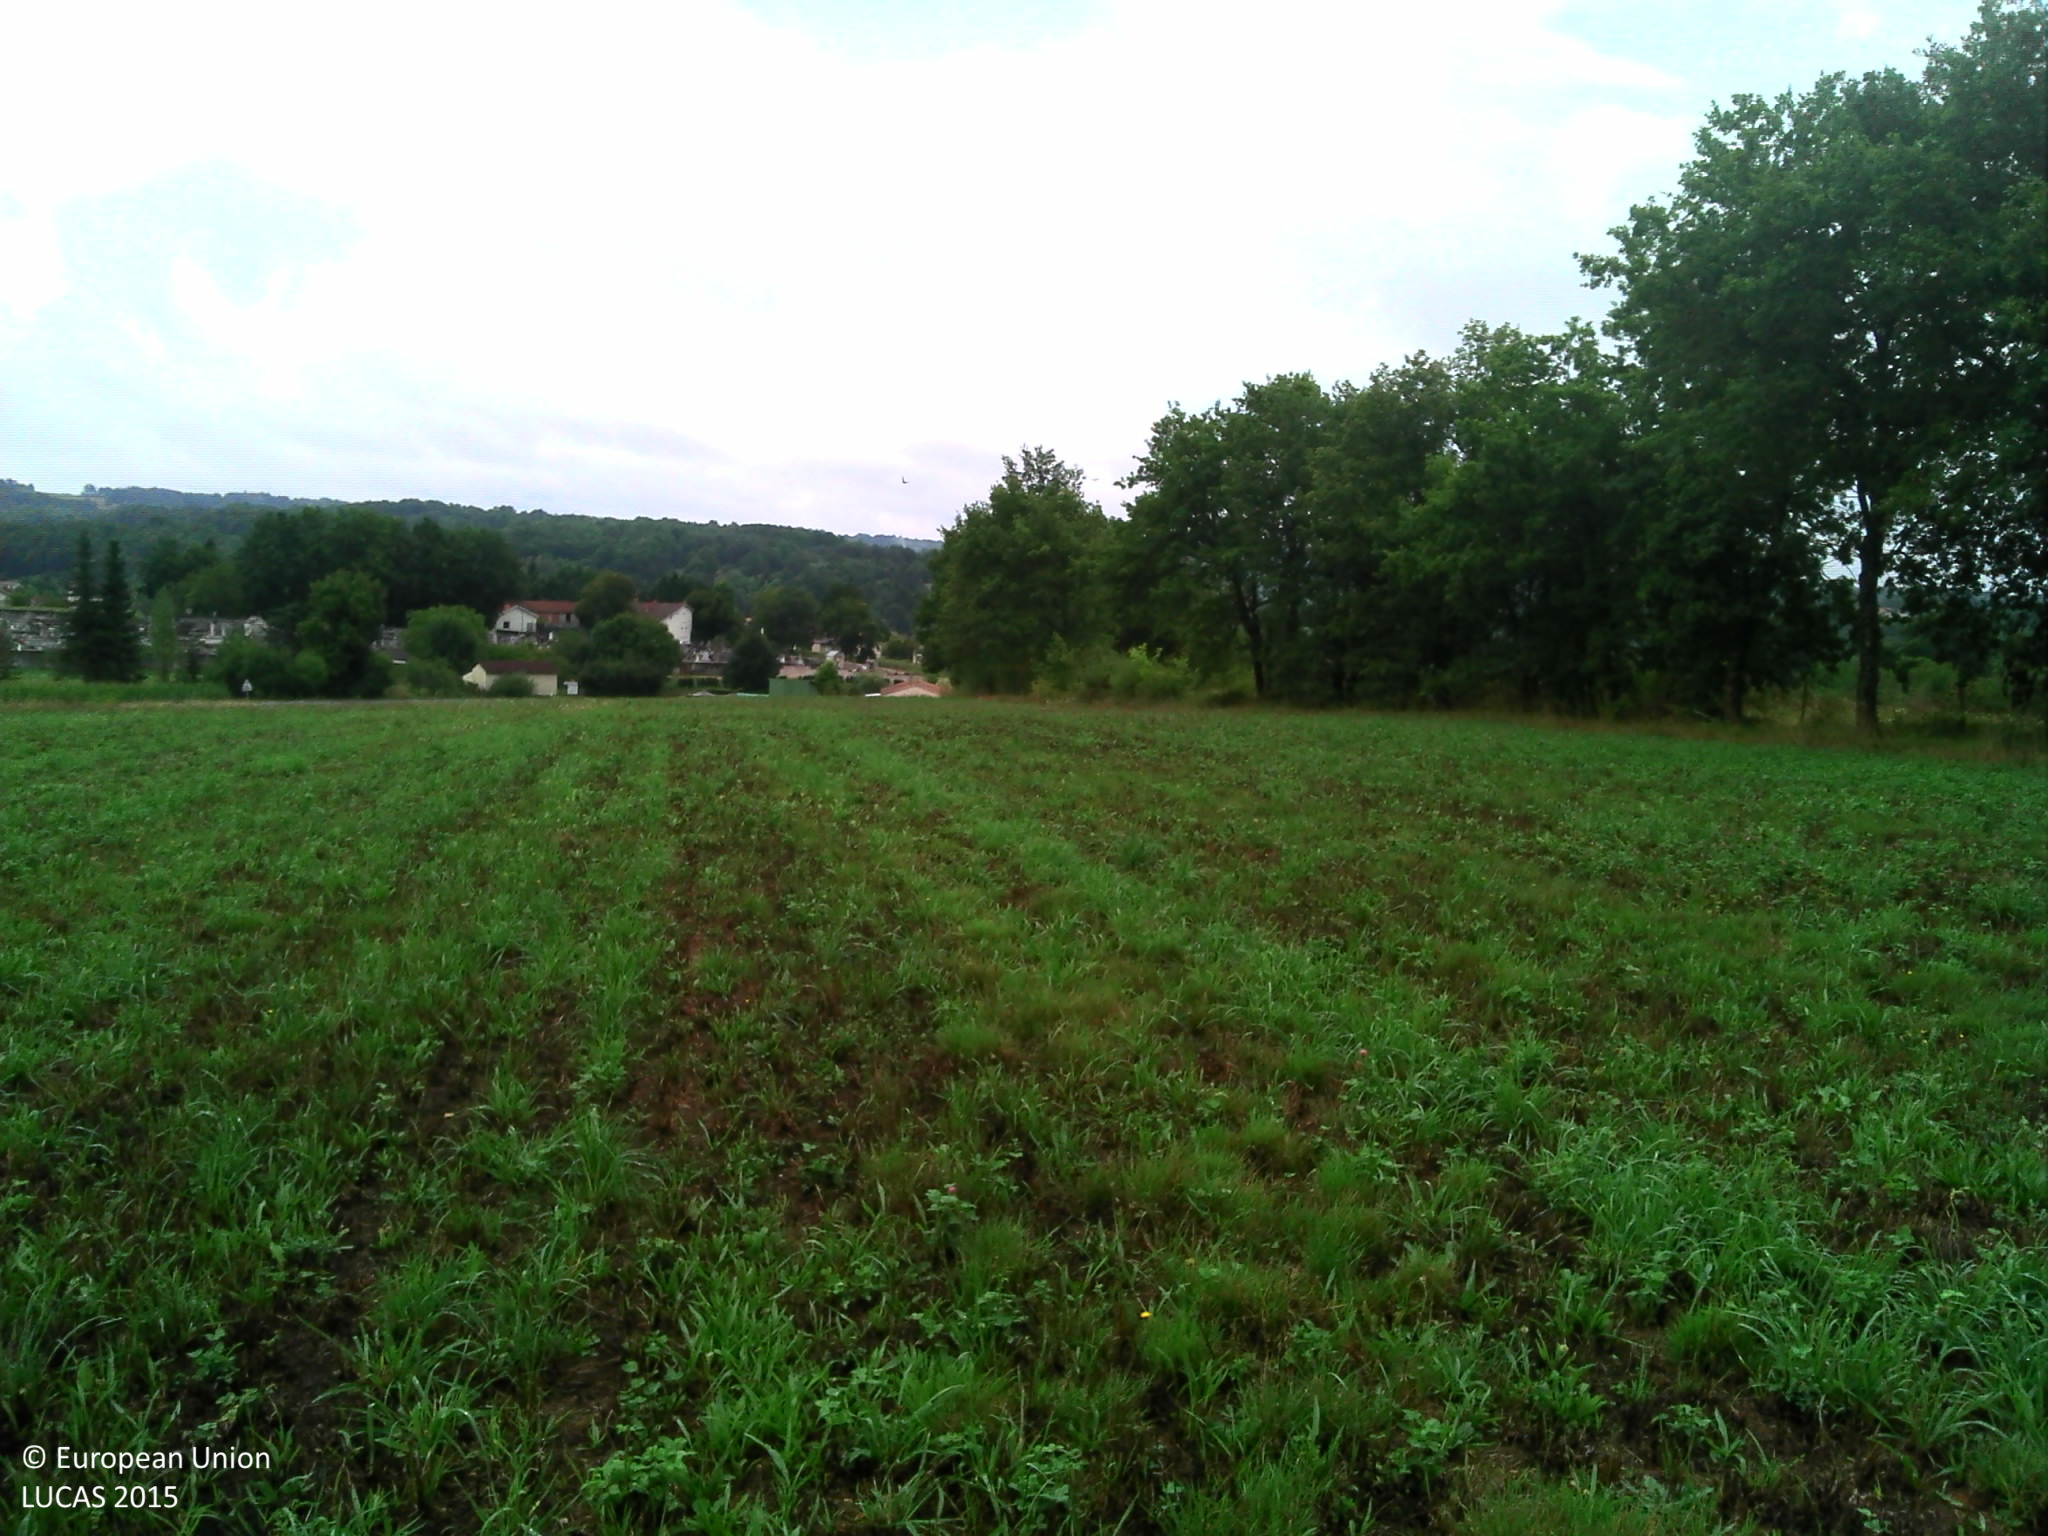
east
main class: Cropland
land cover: Temporary grasslands
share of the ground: 50 - 75 %
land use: Agriculture (excluding fallow land and kitchen gardens)
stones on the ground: < 10 %
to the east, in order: Temporary grasslands; Groves; Temporary grasslands; Artificial constructions in urban areas
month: August
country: FR
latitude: 45.4953
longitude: 0.7369
